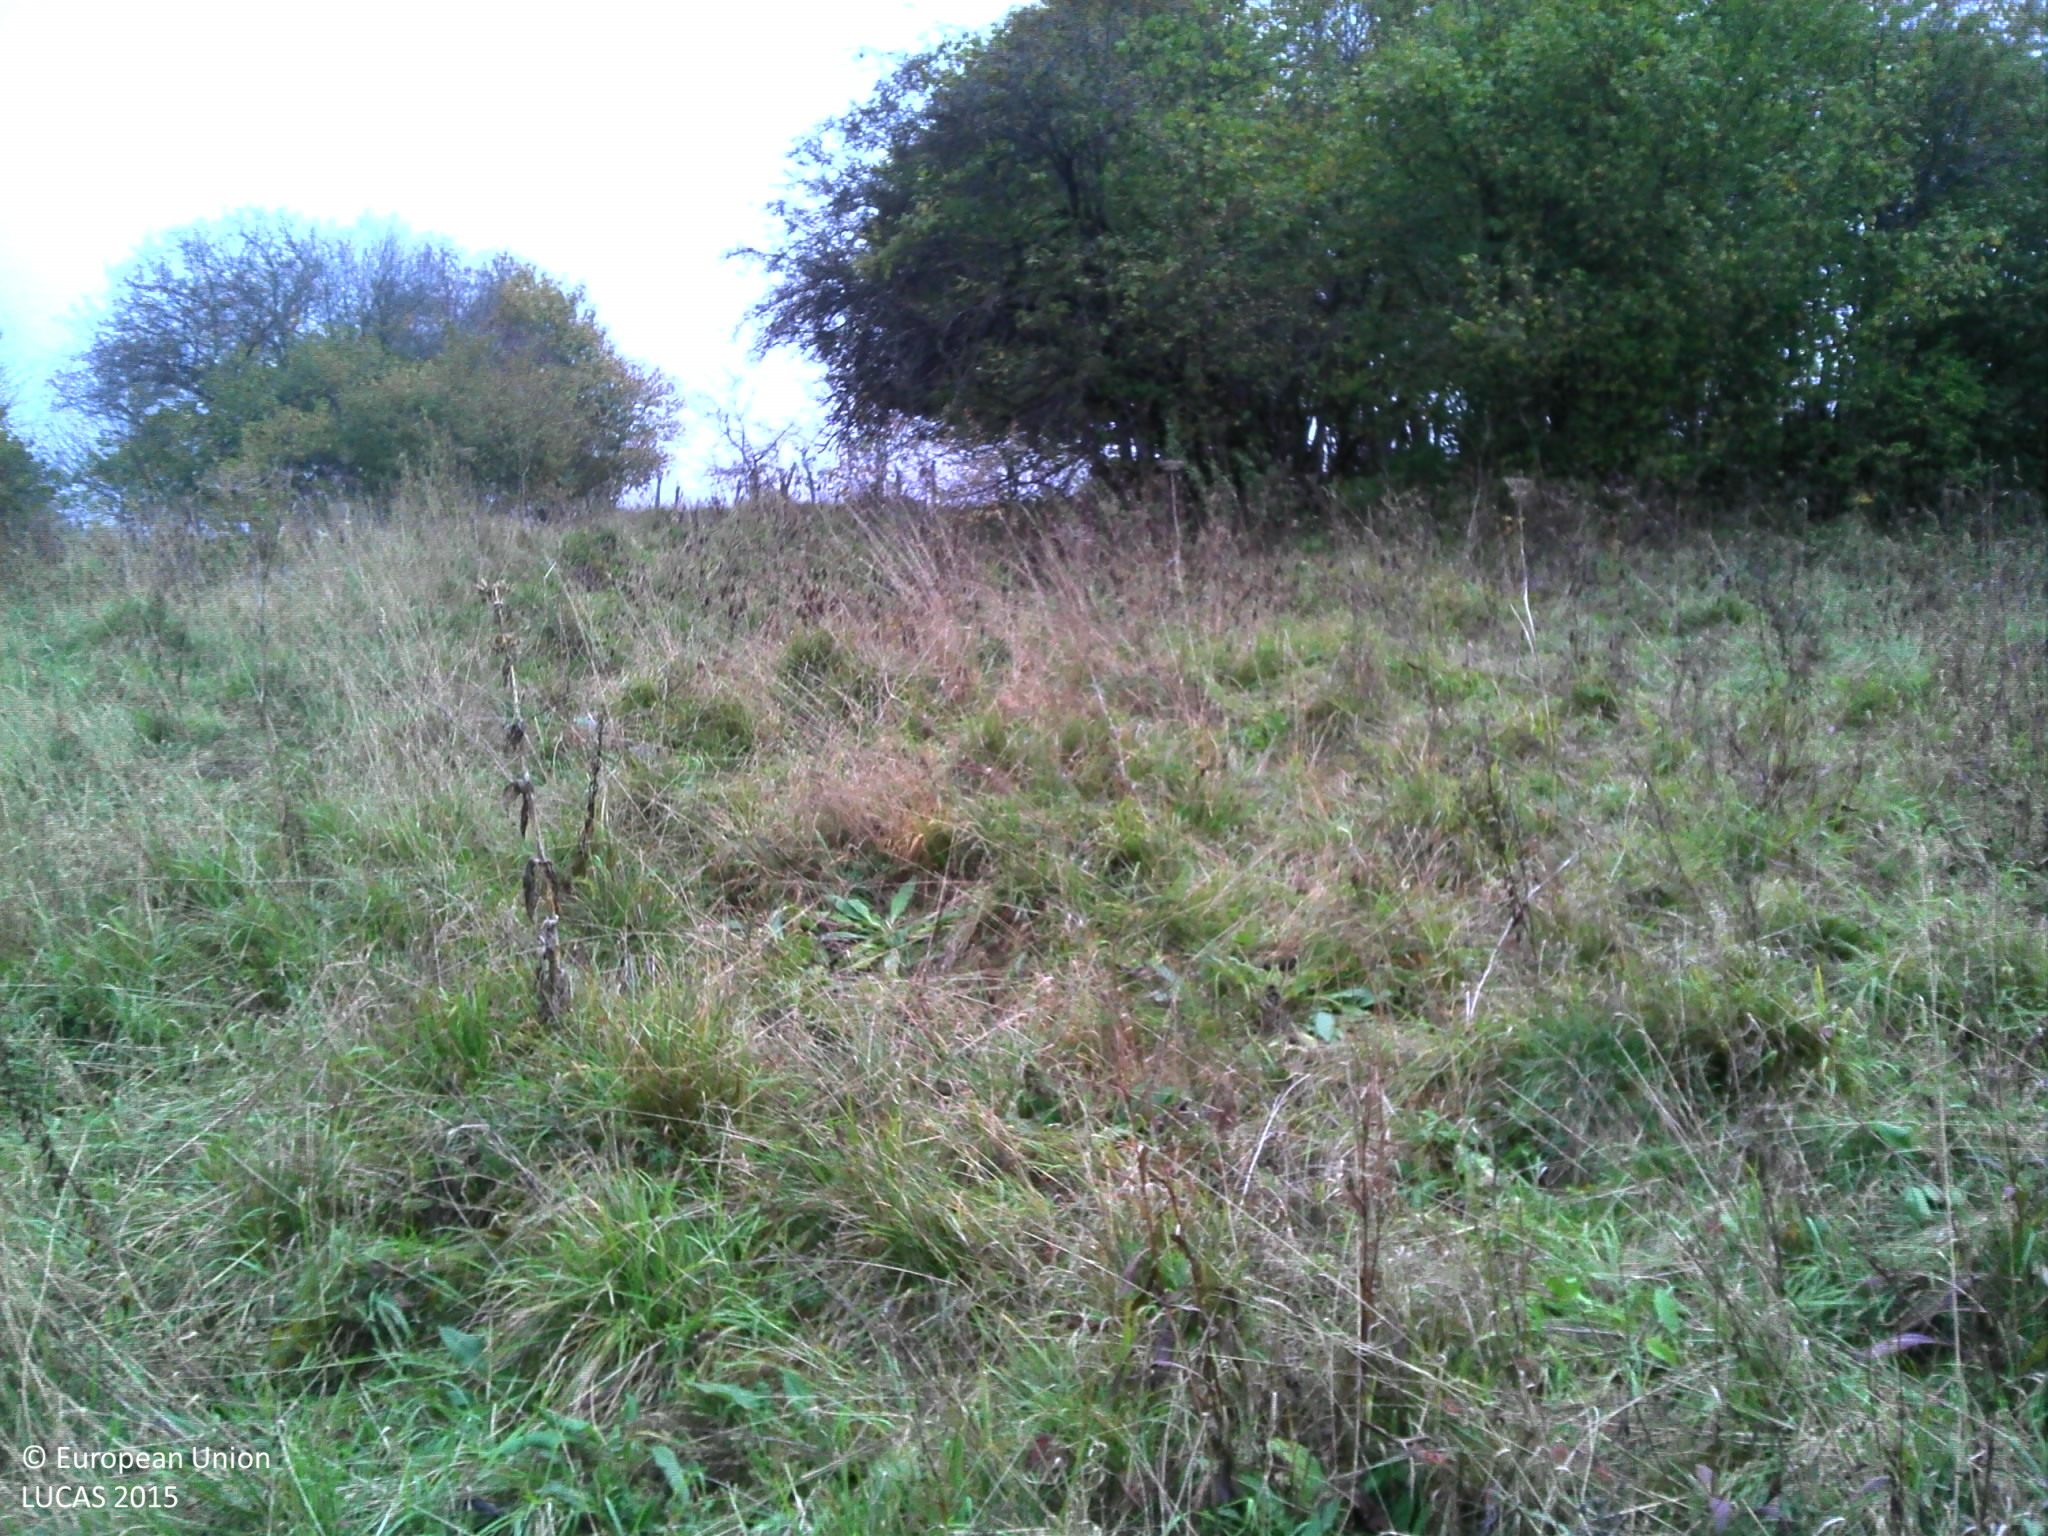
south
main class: Grassland
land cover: Grassland without tree/shrub cover
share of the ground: > 75 %
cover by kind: herbaceous plants 100 %
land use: Agriculture (excluding fallow land and kitchen gardens)
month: October
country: FR
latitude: 46.9131
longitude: 6.1553
